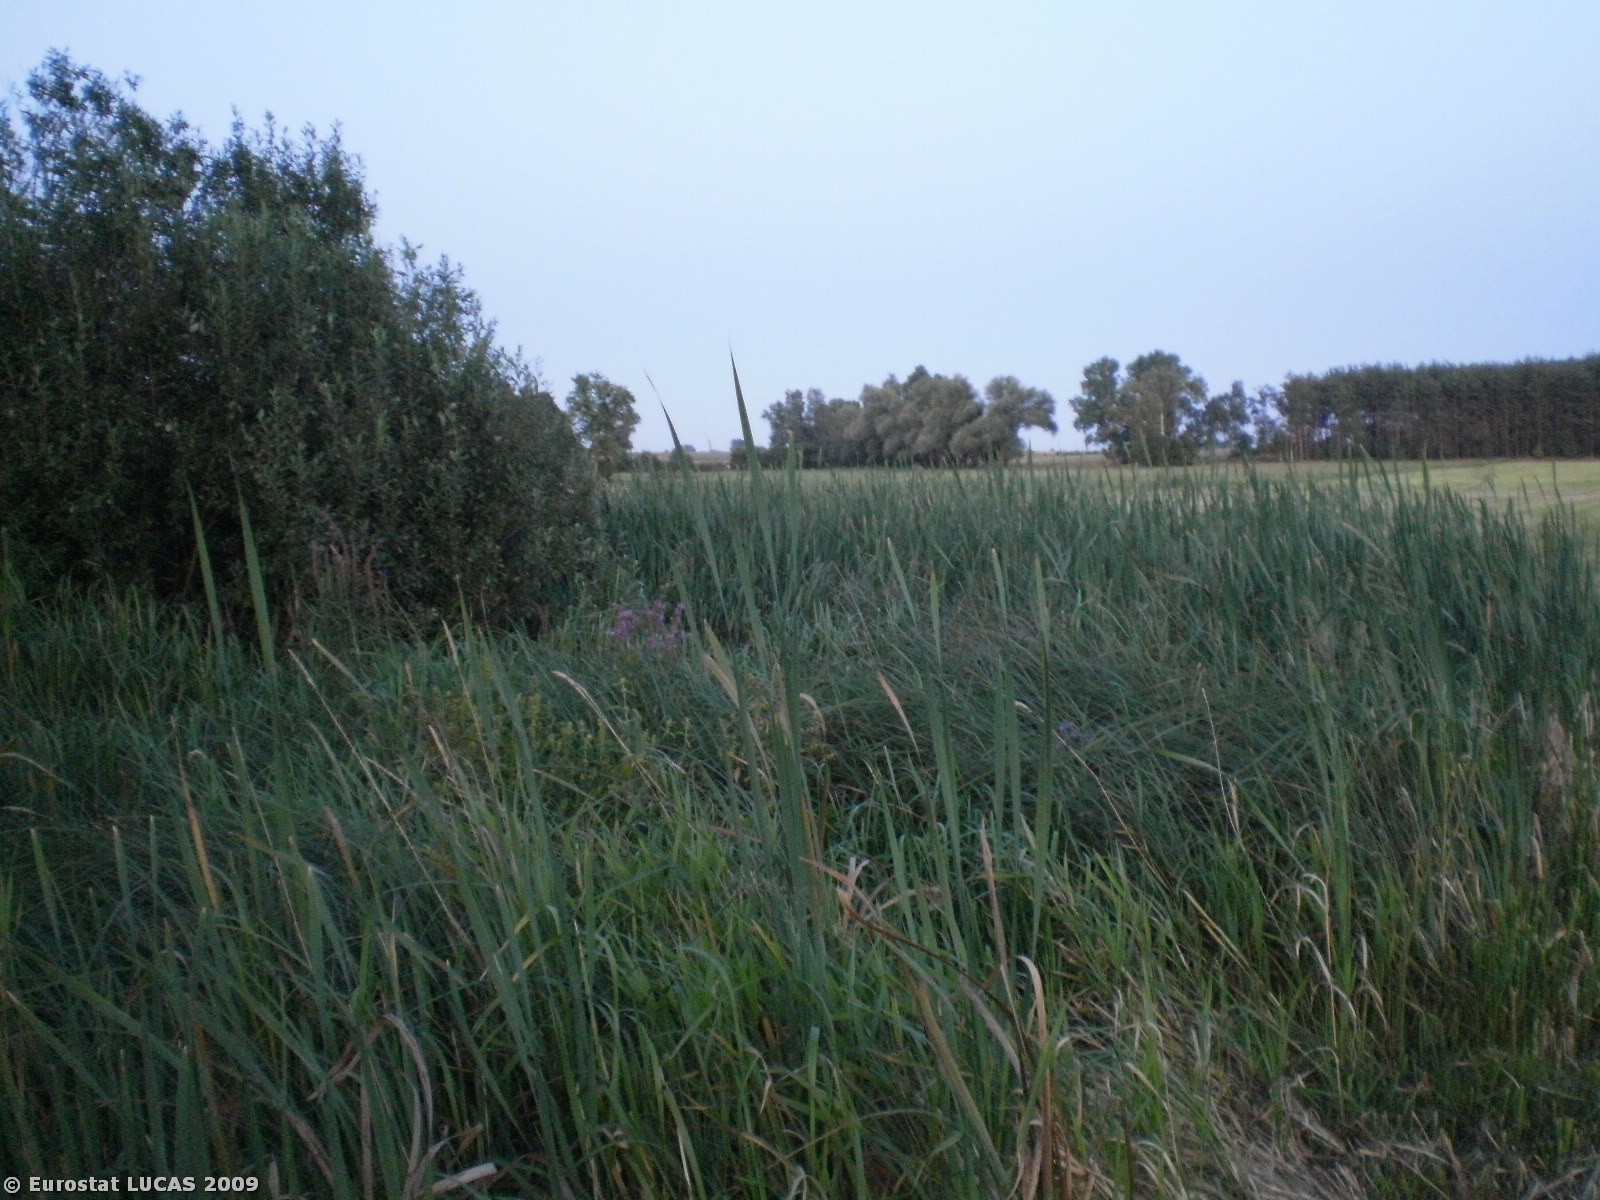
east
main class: Woodland
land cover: Broadleaved woodland
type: mire and swamp forests
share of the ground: 50 - 75 %
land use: Unused
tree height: > 5 m
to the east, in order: Broadleaved woodland; Grassland without tree/shrub cover; Ditches and canals; Grassland without tree/shrub cover; Tracks; Single bushes/trees; Grassland without tree/shrub cover; Broadleaved woodland
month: August
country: PL
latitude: 53.3747
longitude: 21.9159
